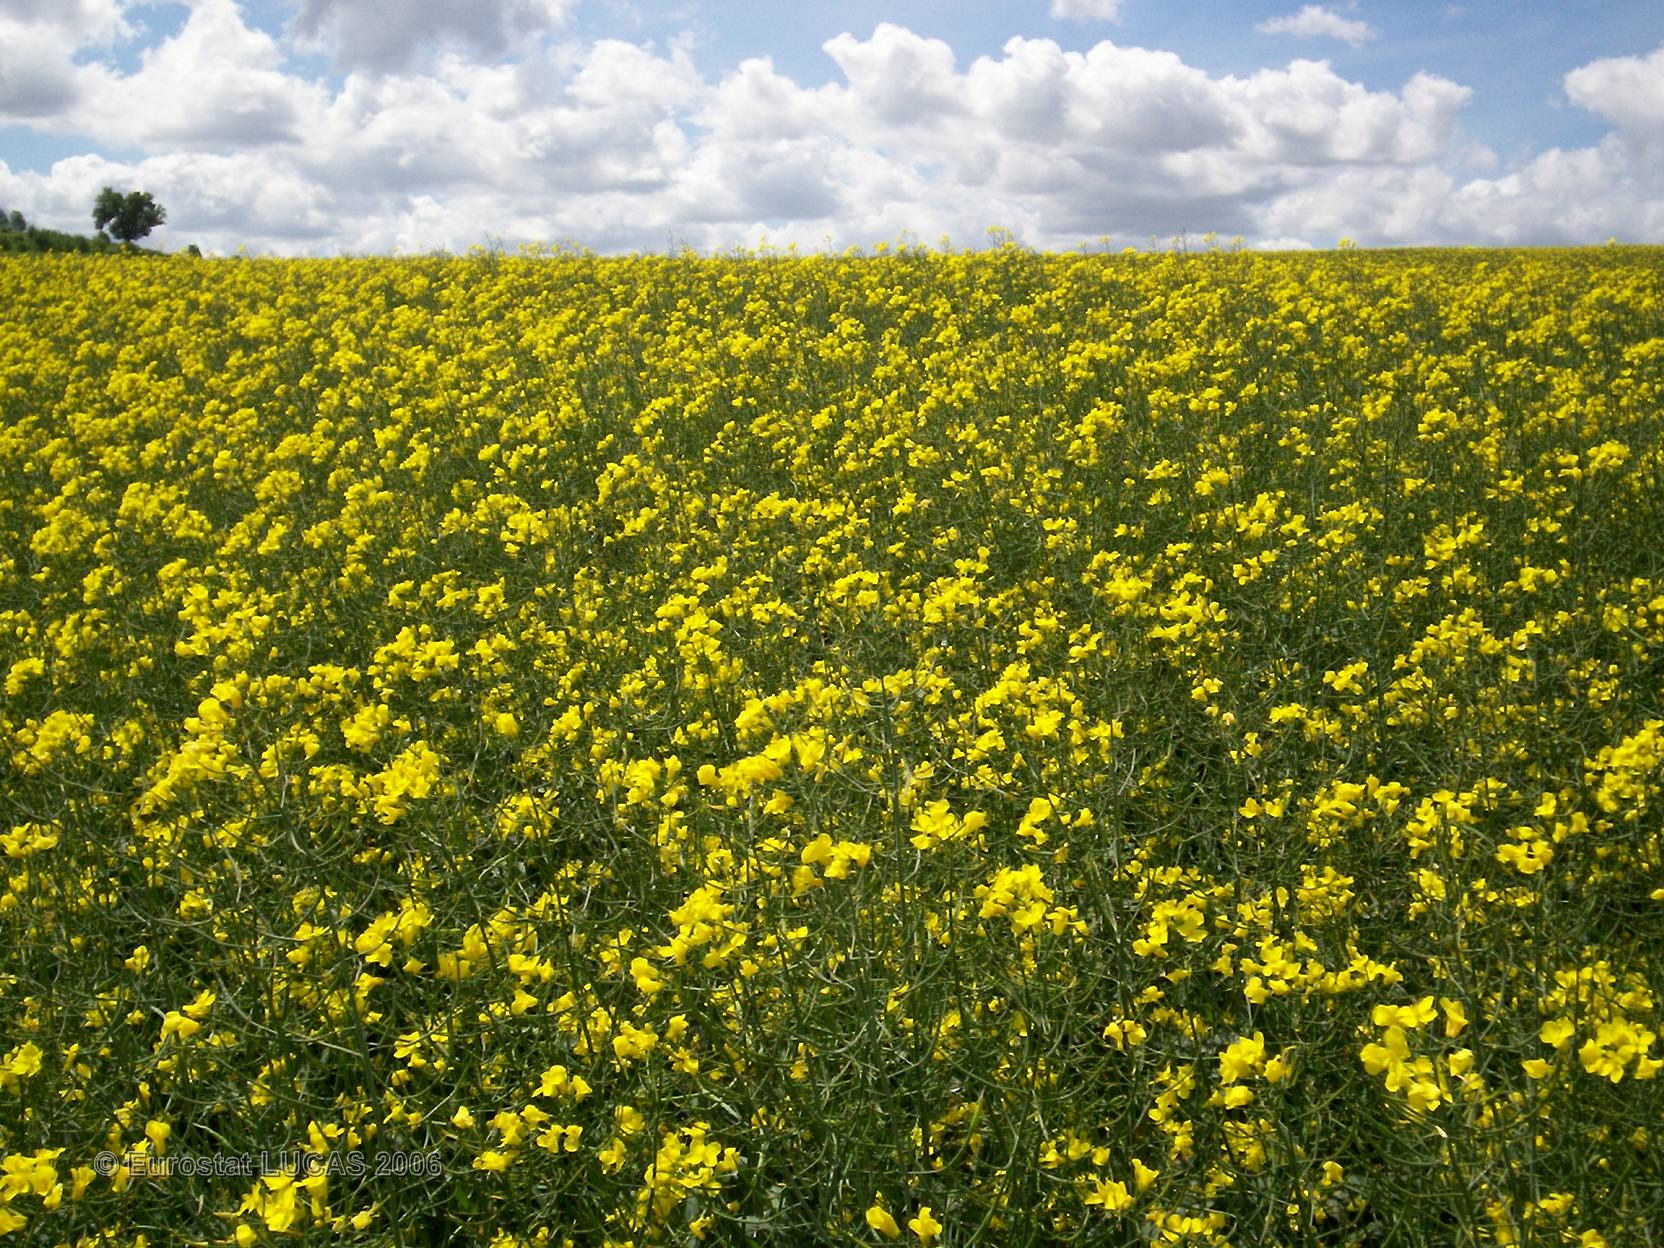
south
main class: Cropland
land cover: Rape and turnip rape
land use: Agriculture (excluding fallow land and kitchen gardens)
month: May
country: FR
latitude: 48.1650
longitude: 4.6334
